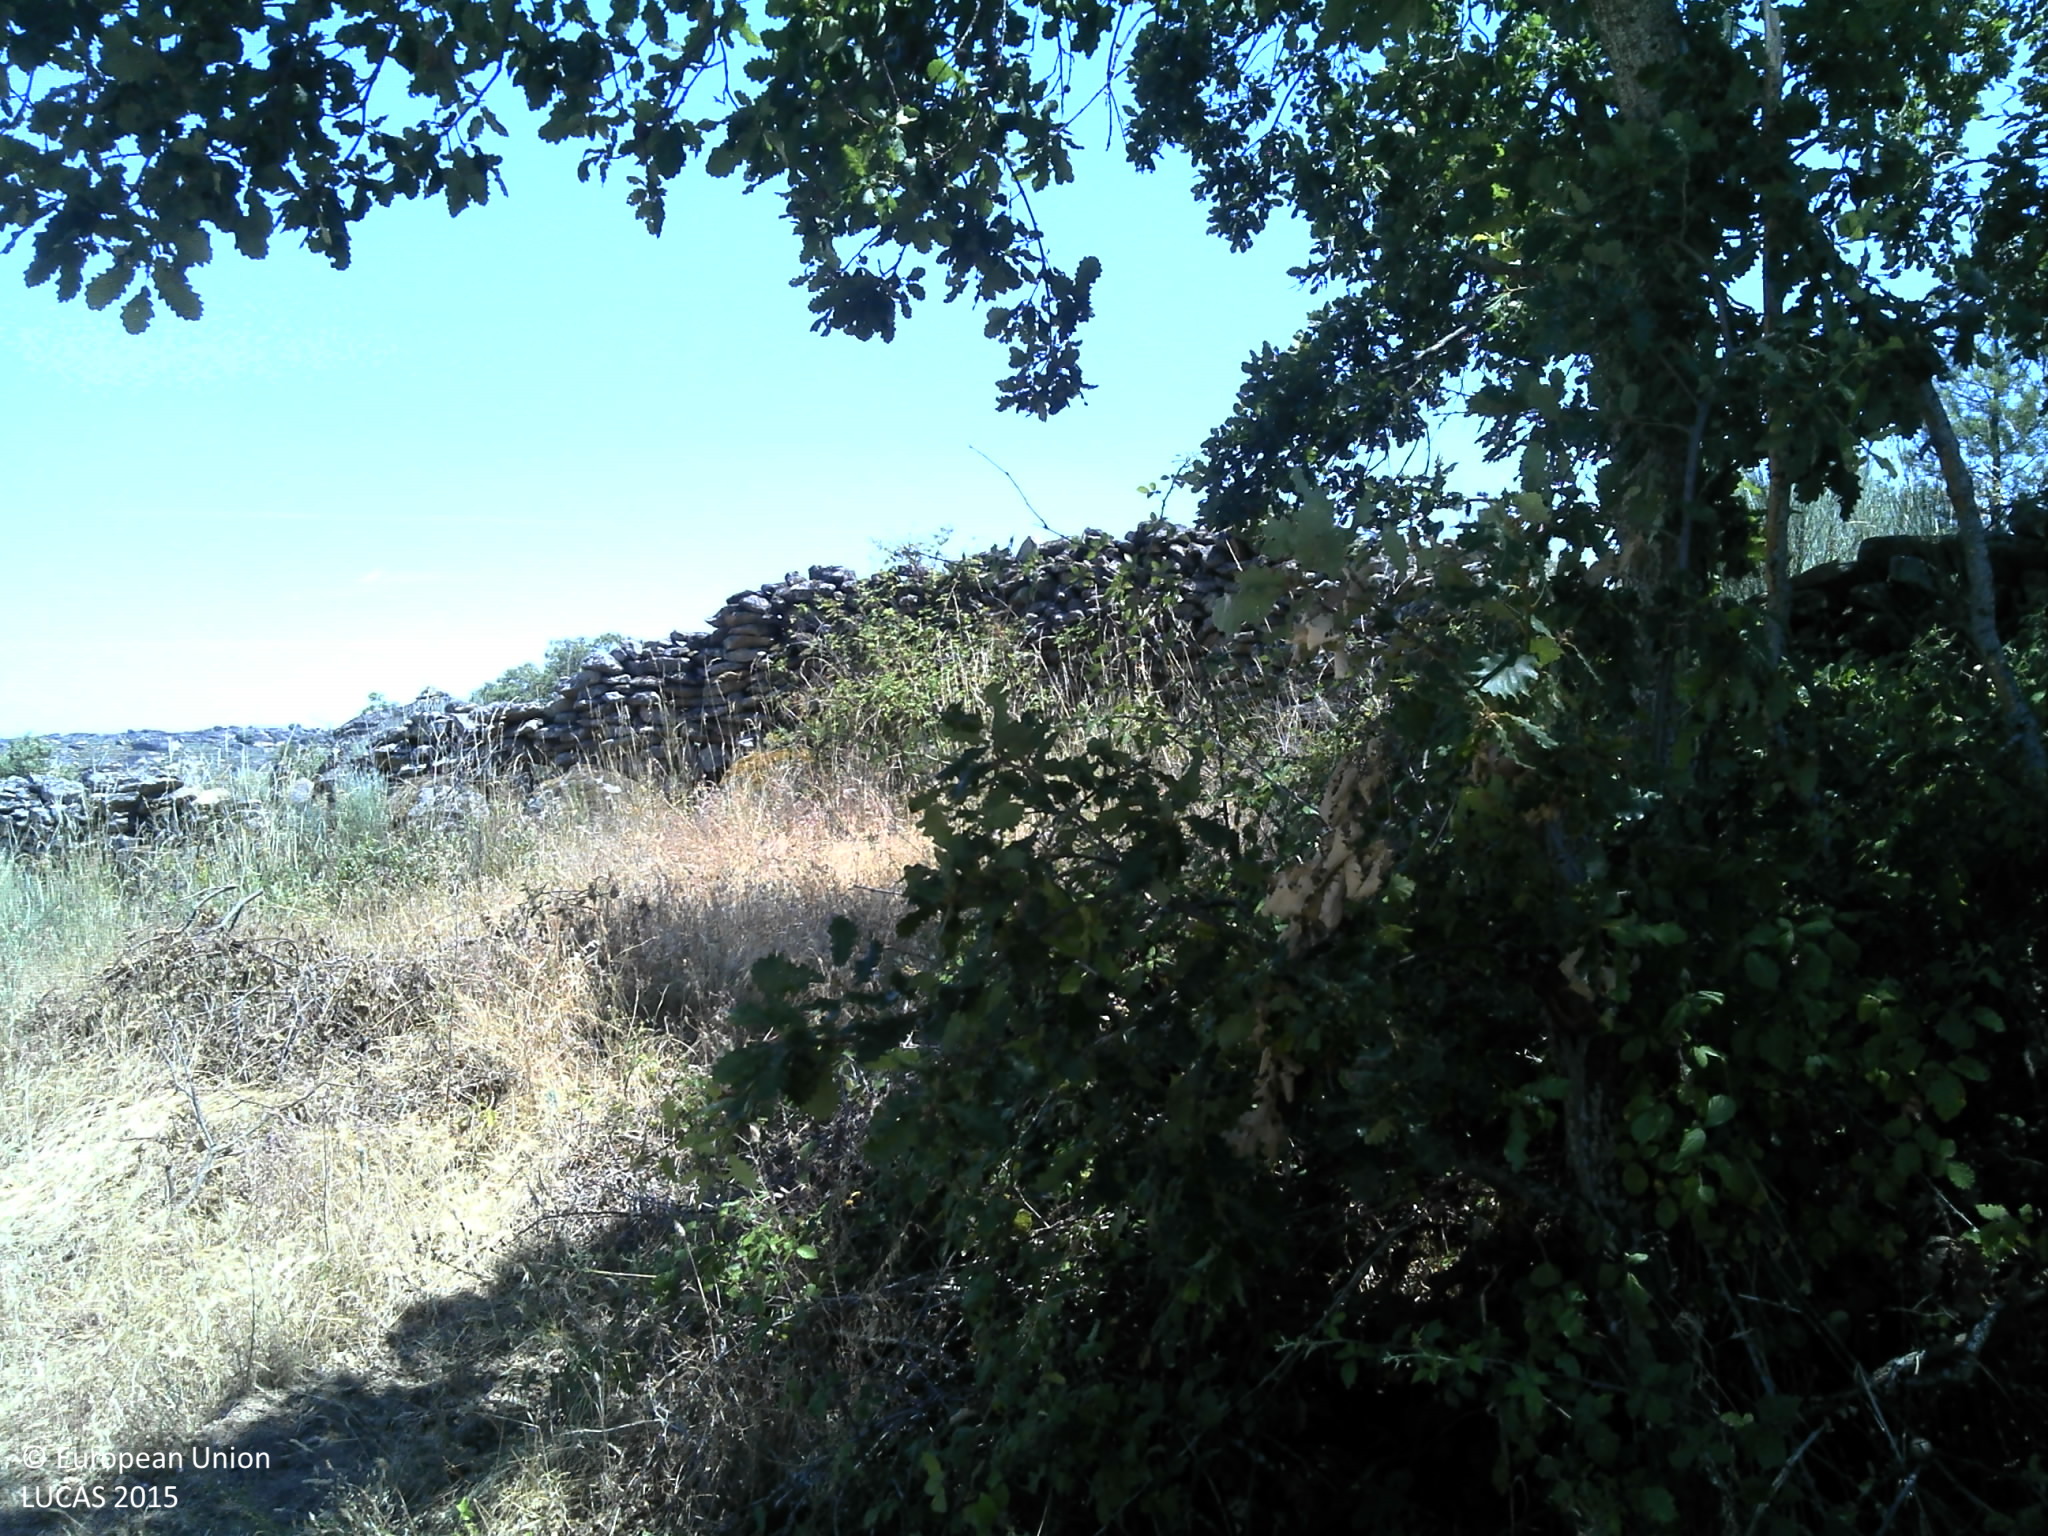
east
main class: Cropland
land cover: Vineyards
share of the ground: < 10 %
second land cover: Other bare soil
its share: > 75 %
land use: Agriculture (excluding fallow land and kitchen gardens)
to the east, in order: Vineyards; Other bare soil; Grassland with sparse tree/shrub cover; Dry stone walls; Shrubland with sparse tree cover; Rock outcrops; Shrubland without tree cover; Shrubland with sparse tree cover; Fences; Rock outcrops; Shrubland with sparse tree cover; Rock outcrops; Shrubland with sparse tree cover
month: June
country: PT
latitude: 40.9274
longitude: -7.0046
